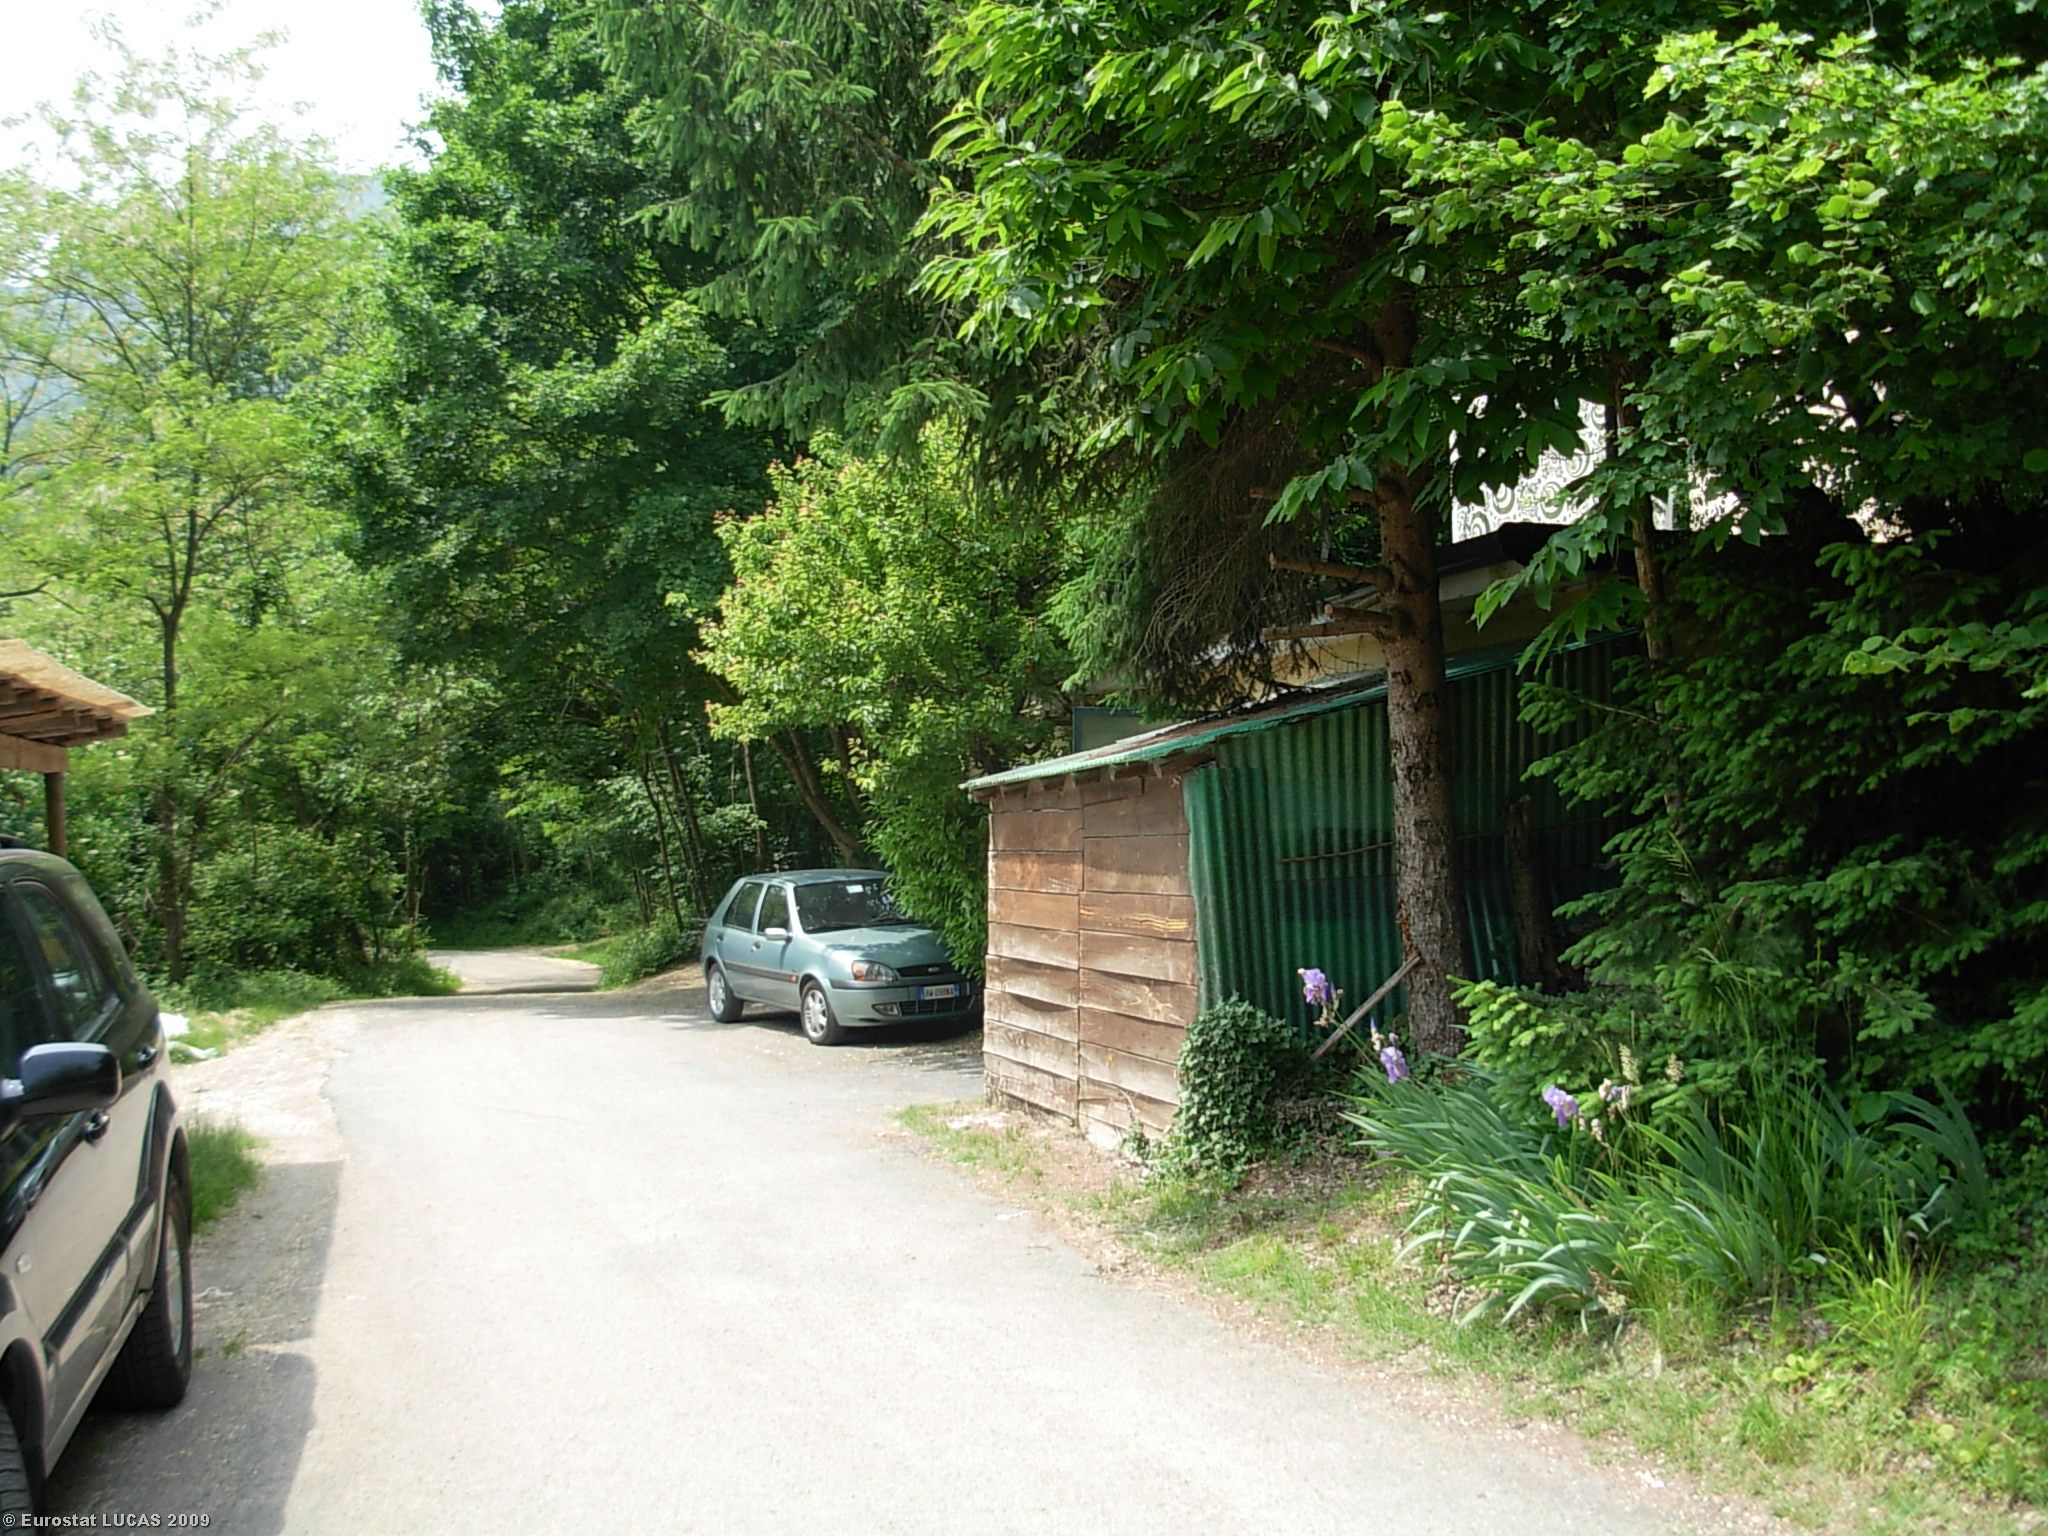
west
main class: Woodland
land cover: Broadleaved woodland
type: mountainous beech forest
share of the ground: > 75 %
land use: Unused
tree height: > 5 m
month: May
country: IT
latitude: 45.5580
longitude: 10.3197
